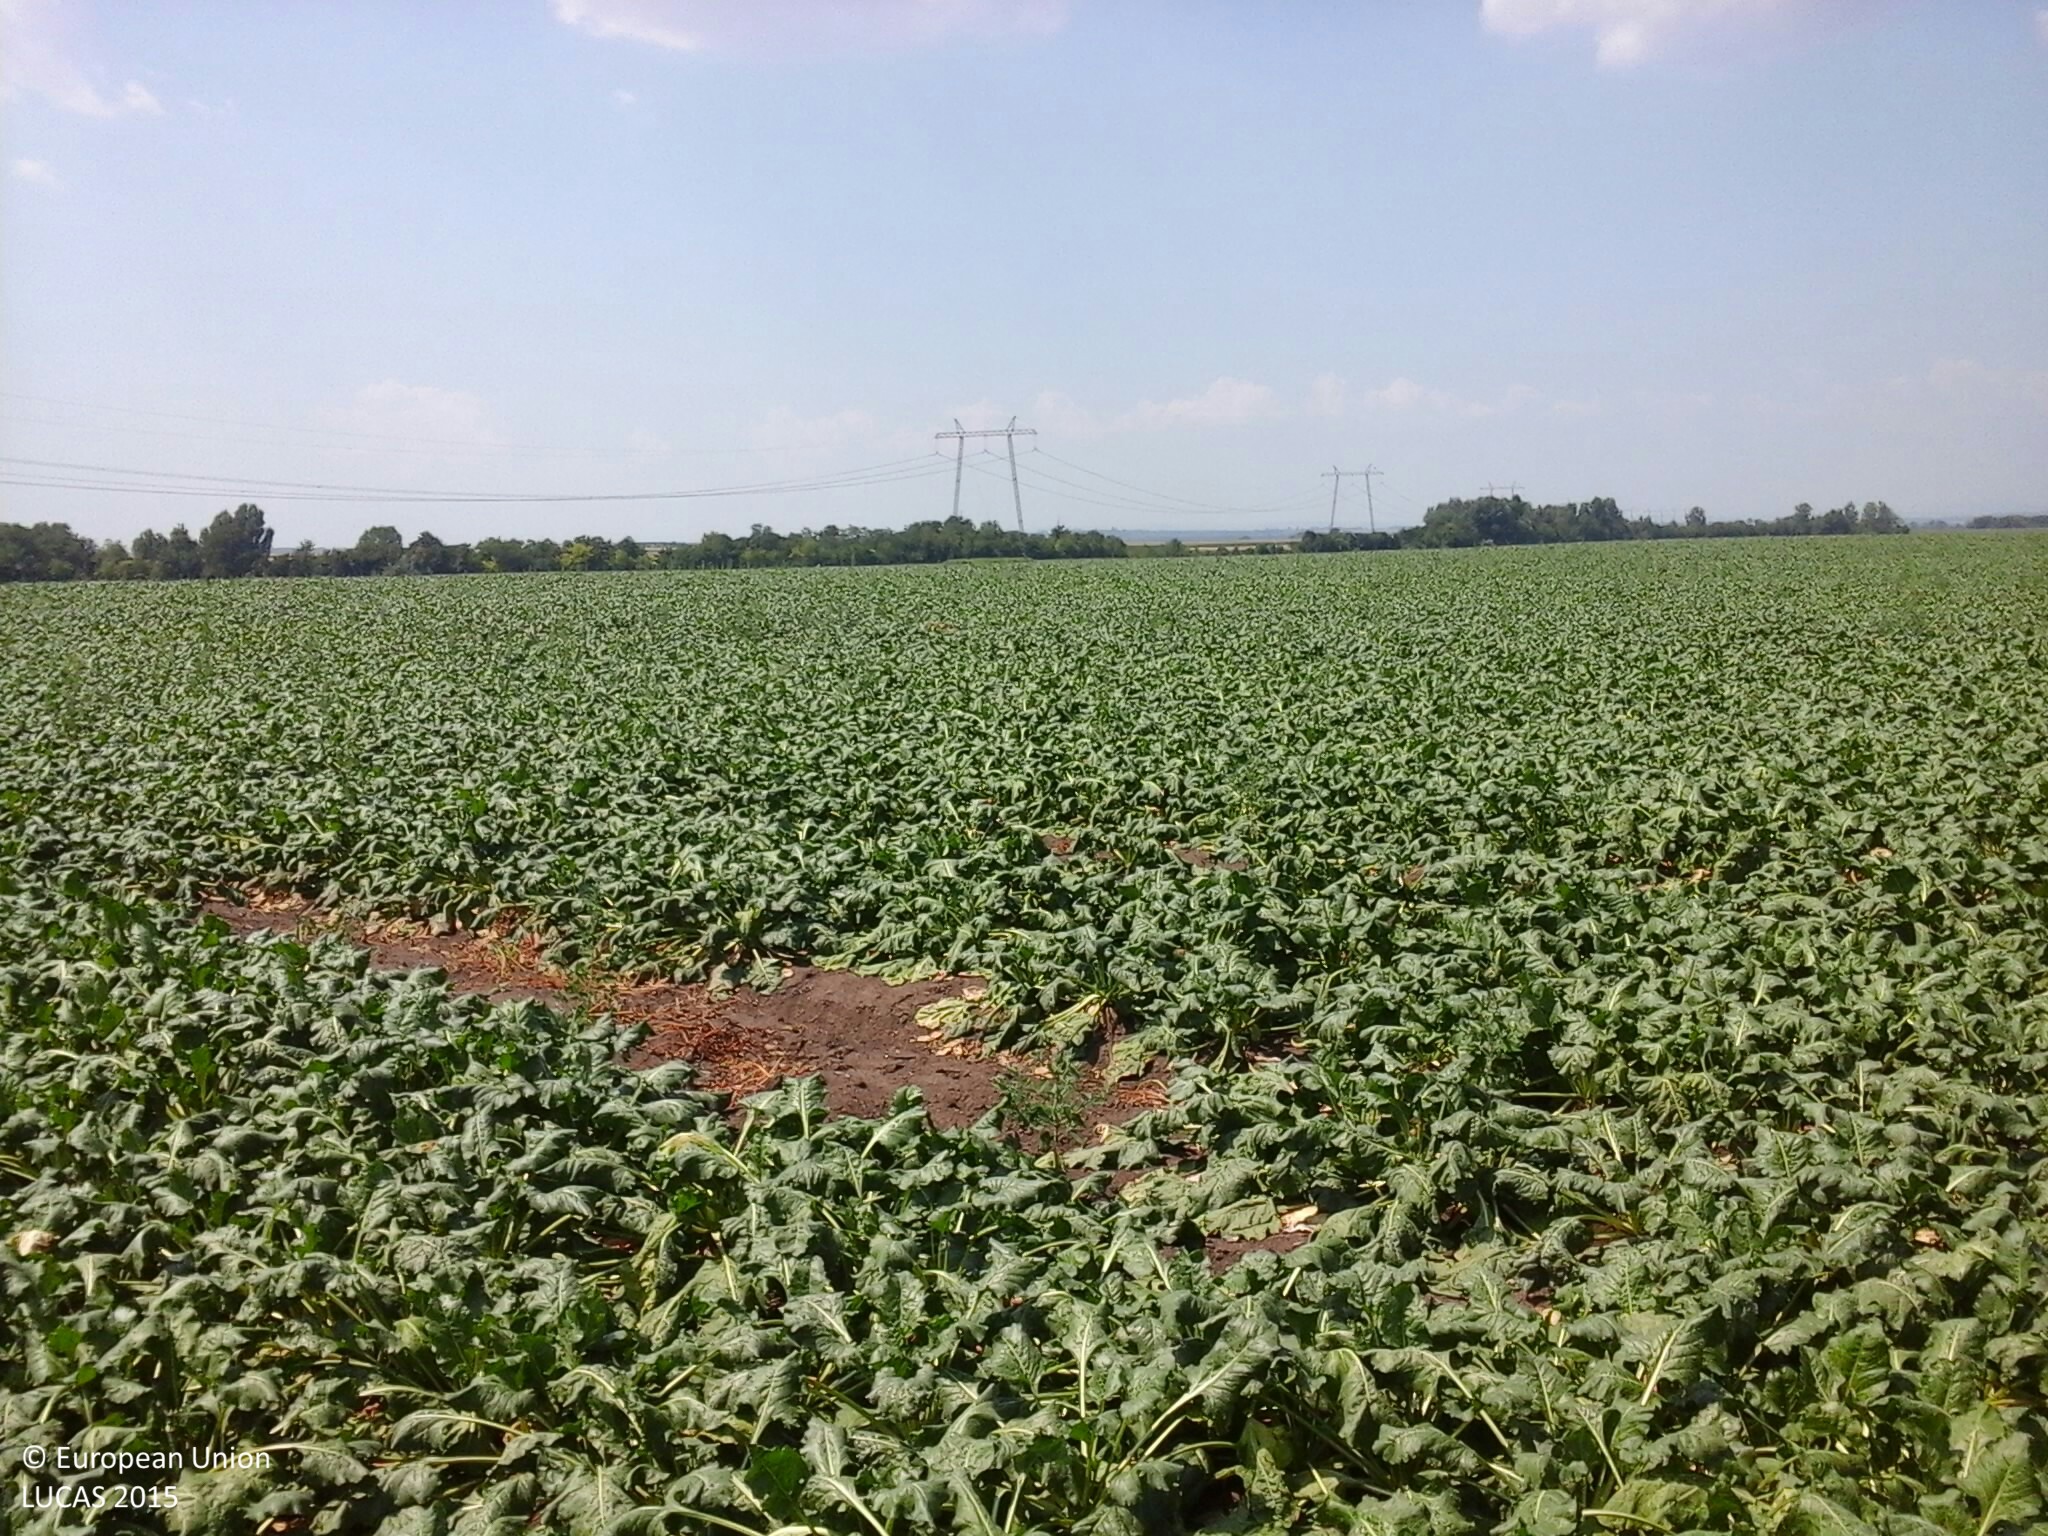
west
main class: Cropland
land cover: Sugar beet
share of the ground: > 75 %
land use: Agriculture (excluding fallow land and kitchen gardens)
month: August
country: HU
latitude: 46.9333
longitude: 18.2987
